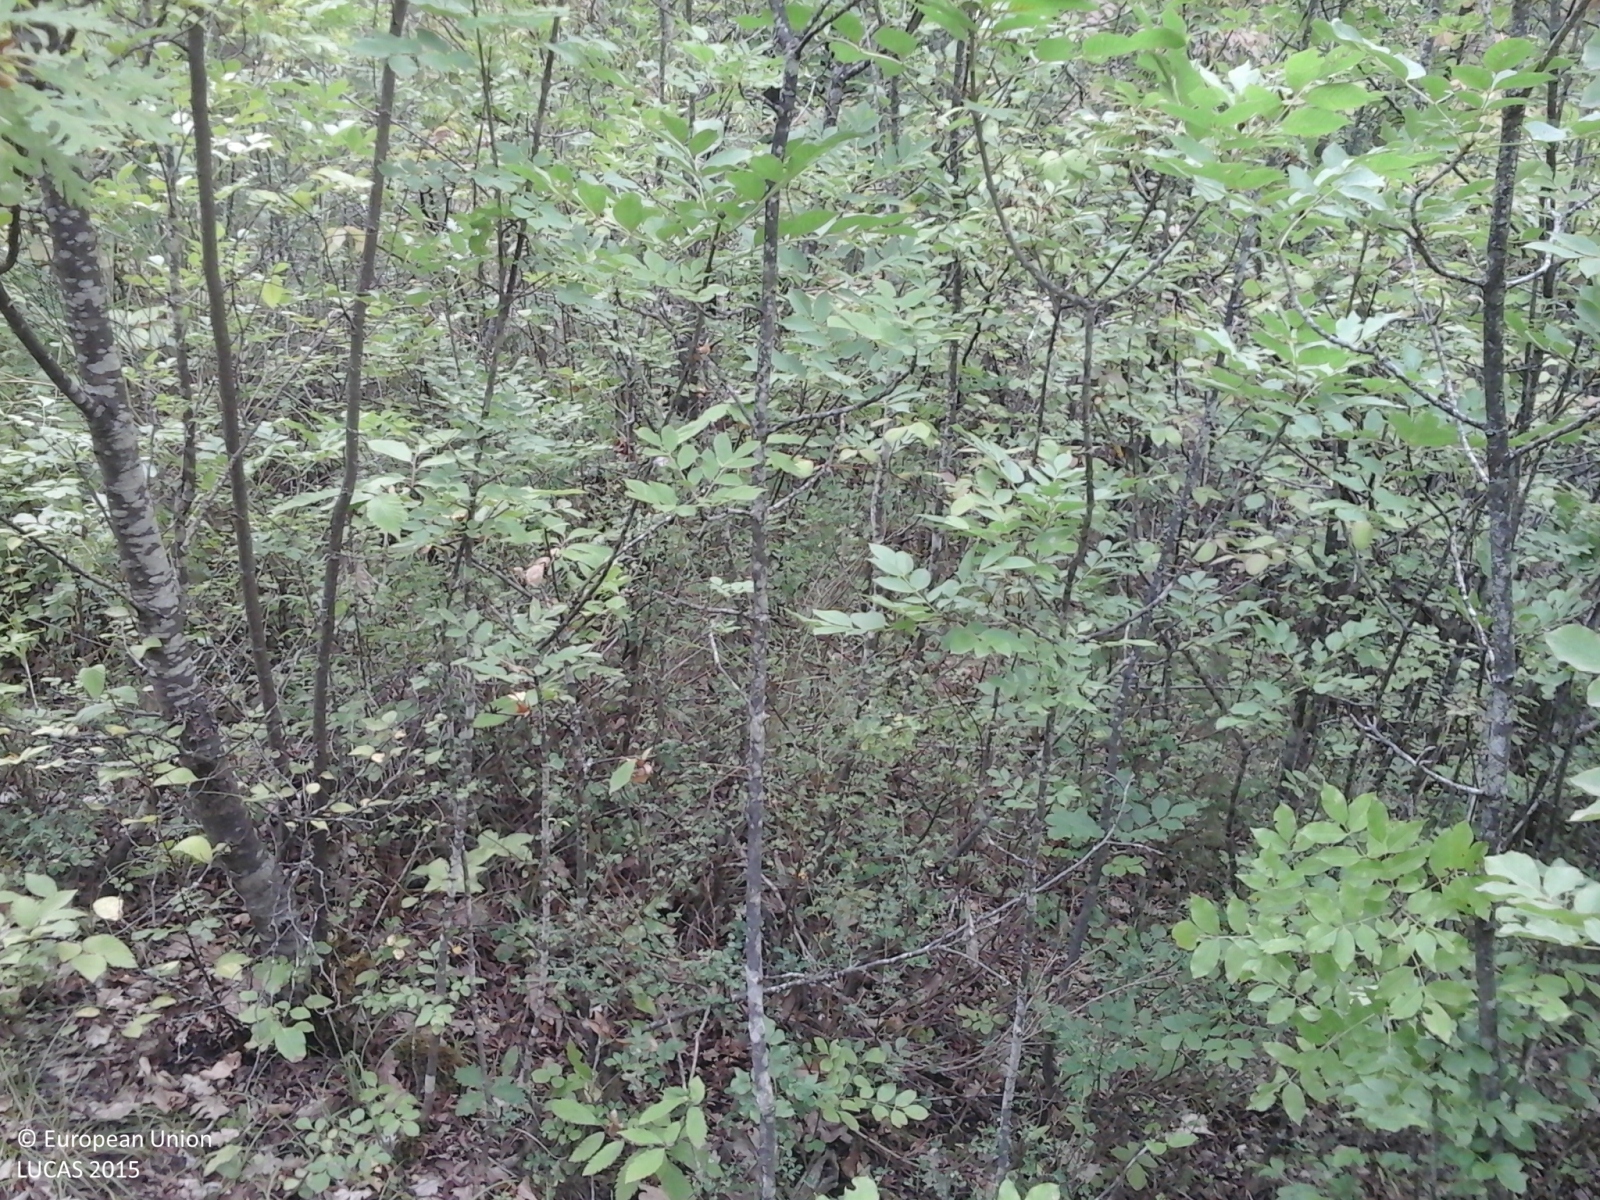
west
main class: Woodland
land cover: Broadleaved woodland
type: thermophilous deciduous forest
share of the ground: > 75 %
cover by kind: broadleaved forest trees 95 %, unconsolidated bare surface 5 %
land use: Forestry
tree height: < 5 m
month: August
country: IT
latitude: 44.8162
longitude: 9.1797
